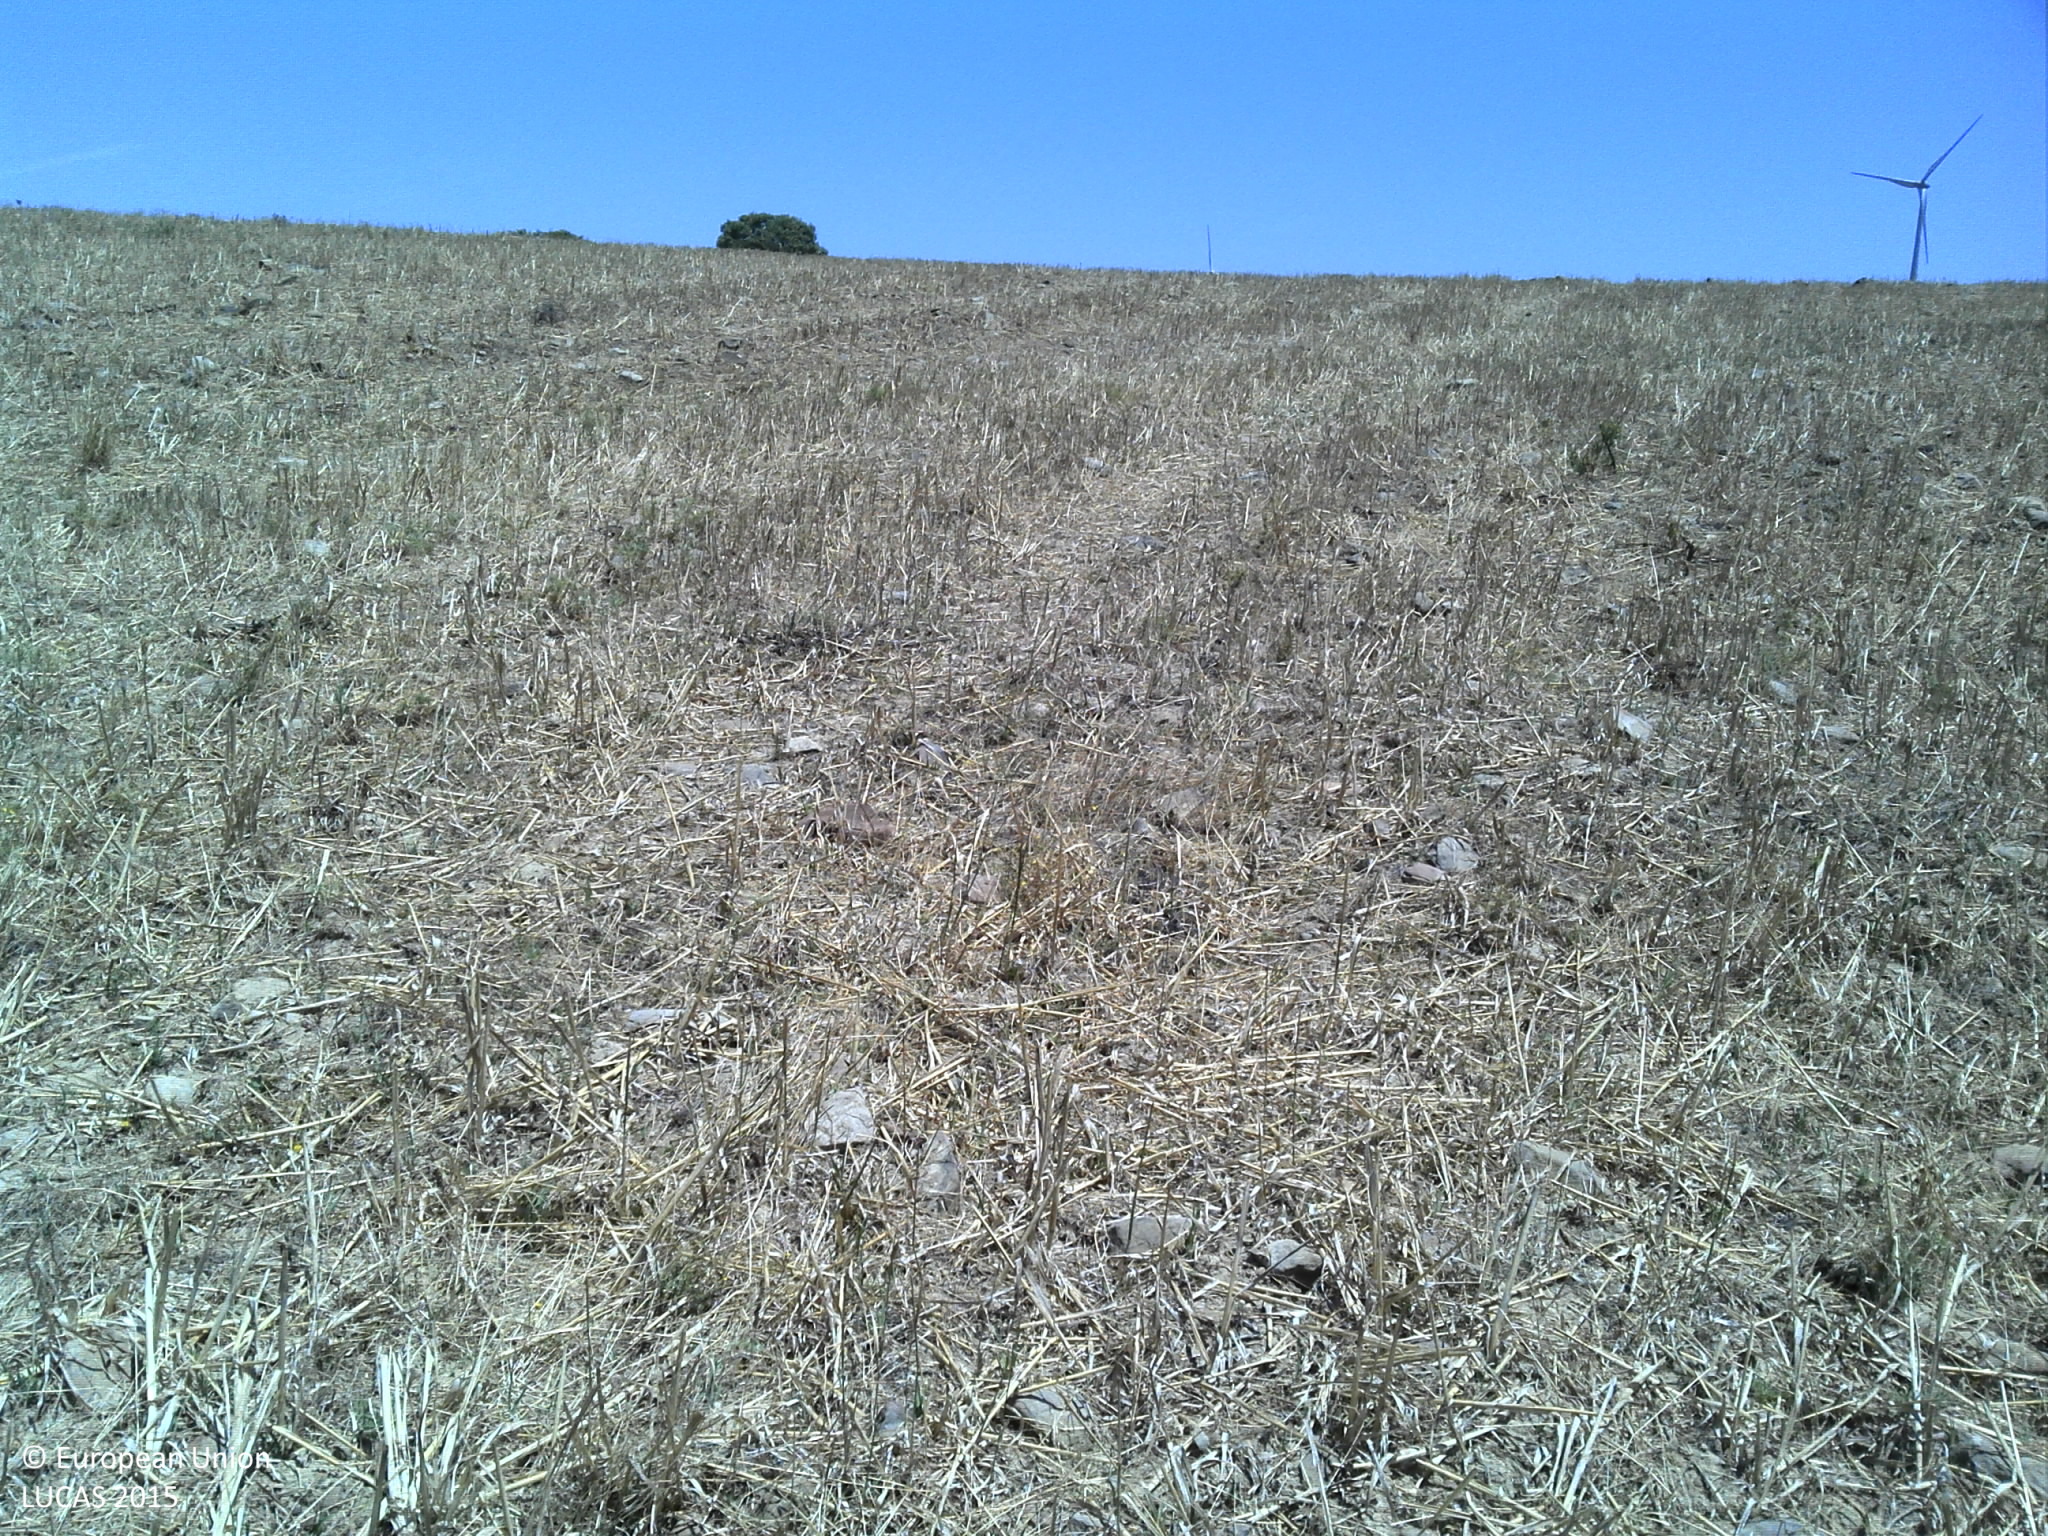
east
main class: Cropland
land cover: Oats
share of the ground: 50 - 75 %
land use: Agriculture (excluding fallow land and kitchen gardens)
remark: Harvested field
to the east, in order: Oats; Tracks; Oats; Fences; Shruby margins; Fences; Grass margins; Other bare soil; Rock outcrops; Other bare soil
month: July
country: PT
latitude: 37.5047
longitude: -7.8566
